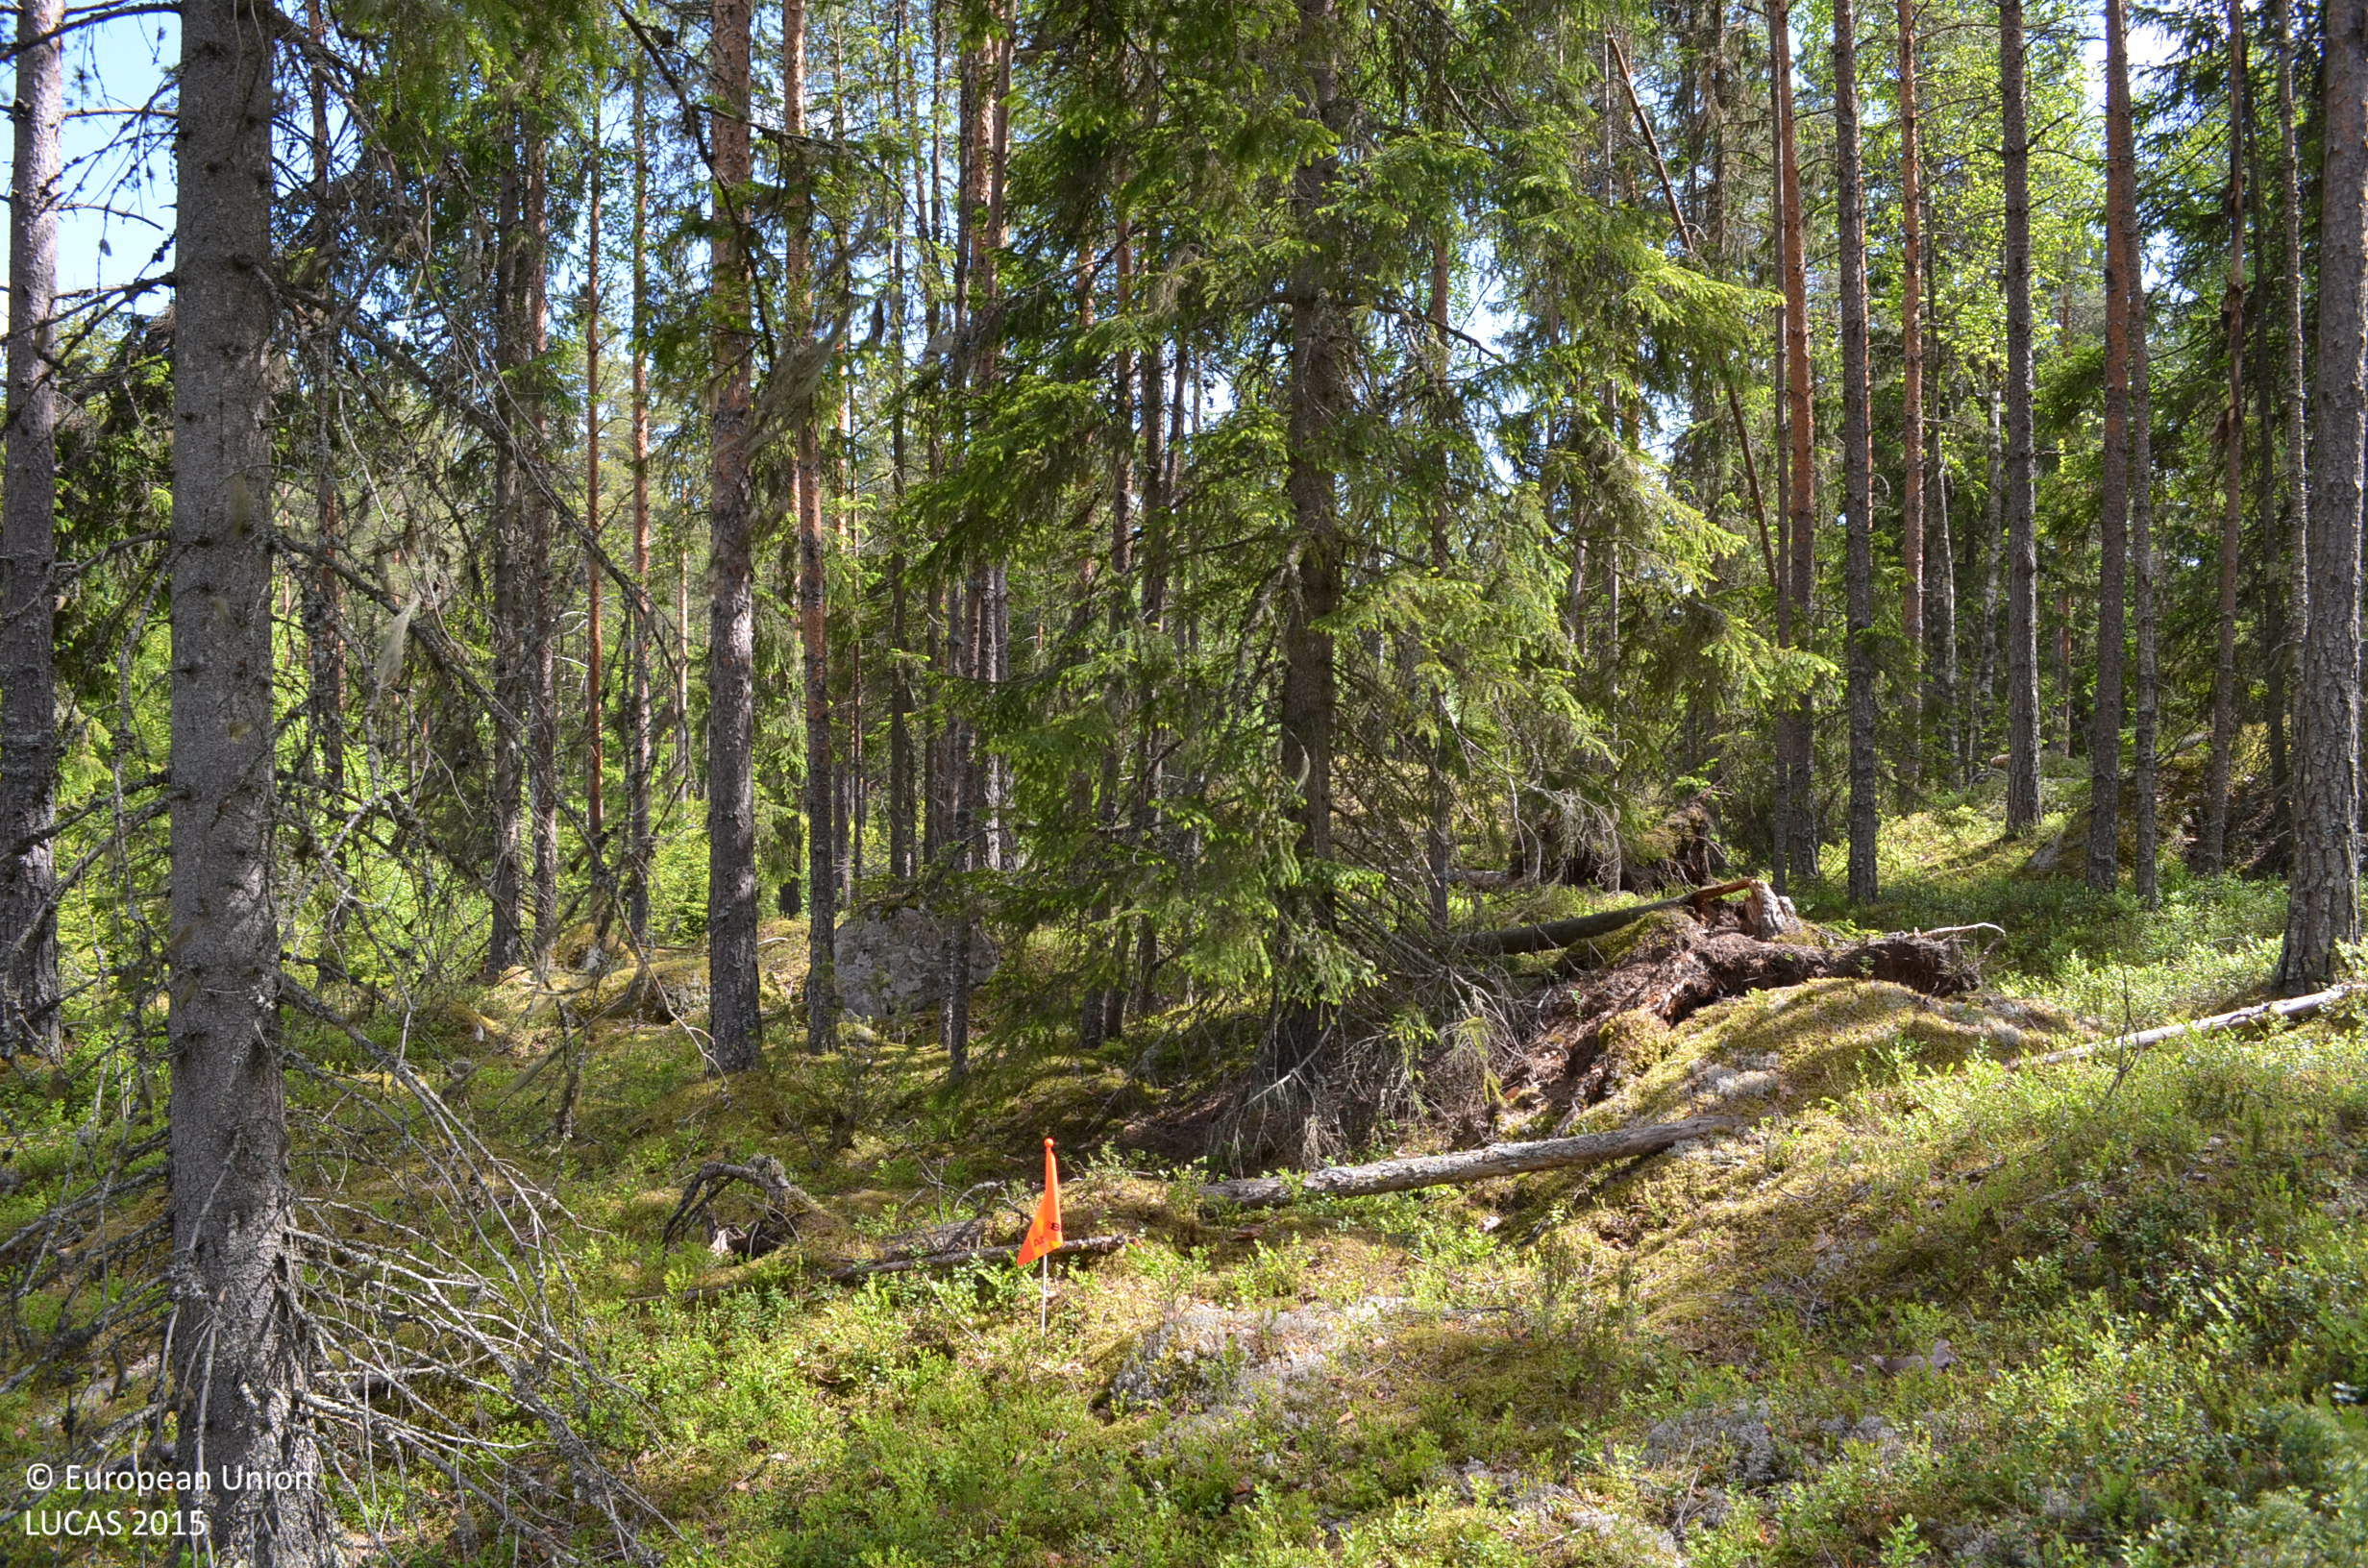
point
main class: Woodland
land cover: Other coniferous woodland
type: boreal forest
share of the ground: 50 - 75 %
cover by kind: coniferous forest trees 70 %, shrubs 25 %, lichens and mosses 5 %
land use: Forestry
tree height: > 5 m
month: June
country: FI
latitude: 61.8062
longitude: 23.2208
